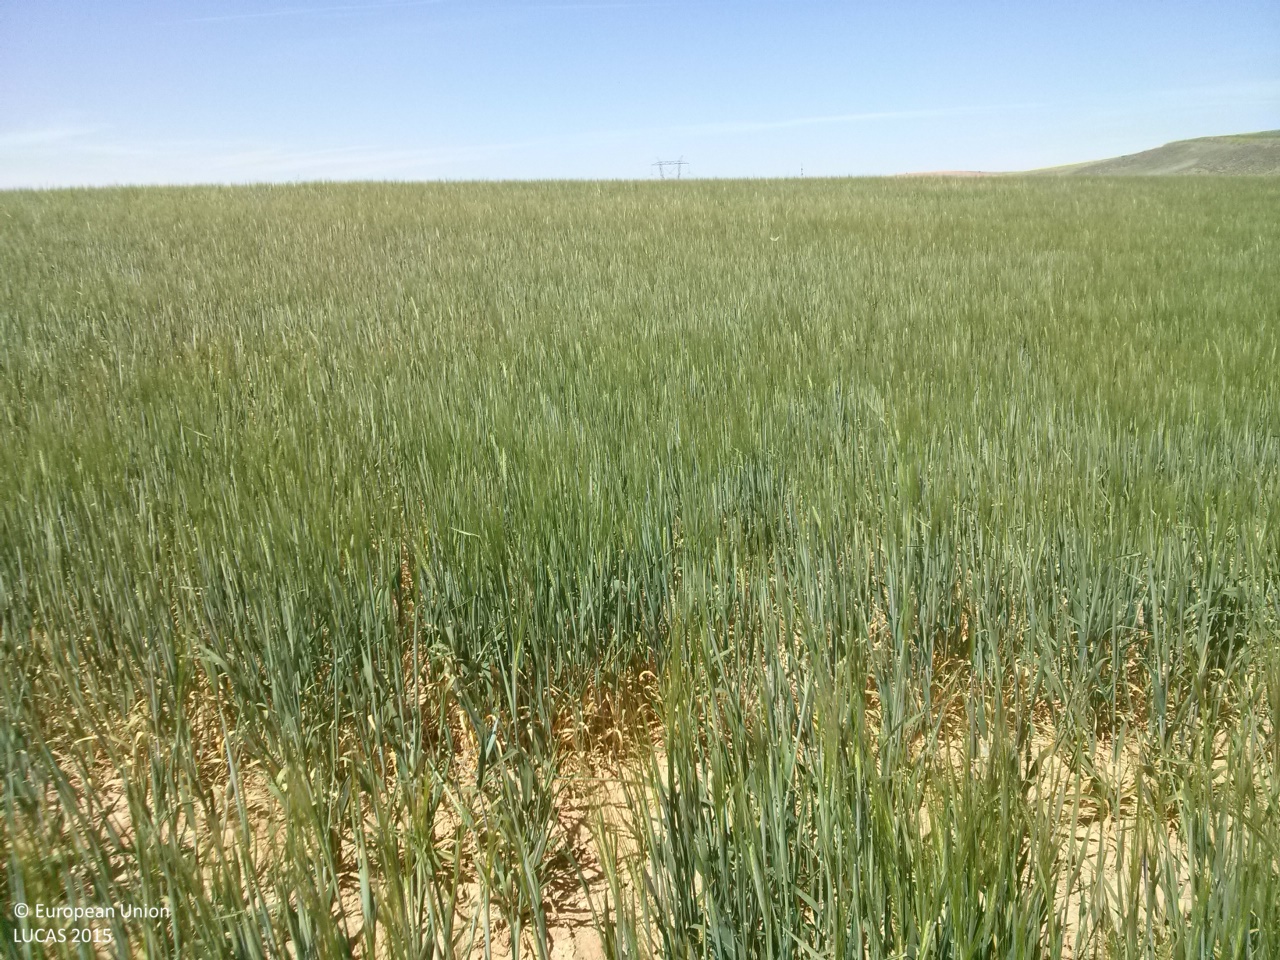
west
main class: Cropland
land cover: Barley
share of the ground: > 75 %
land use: Agriculture (excluding fallow land and kitchen gardens)
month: May
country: ES
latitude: 39.9241
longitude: -2.7617
